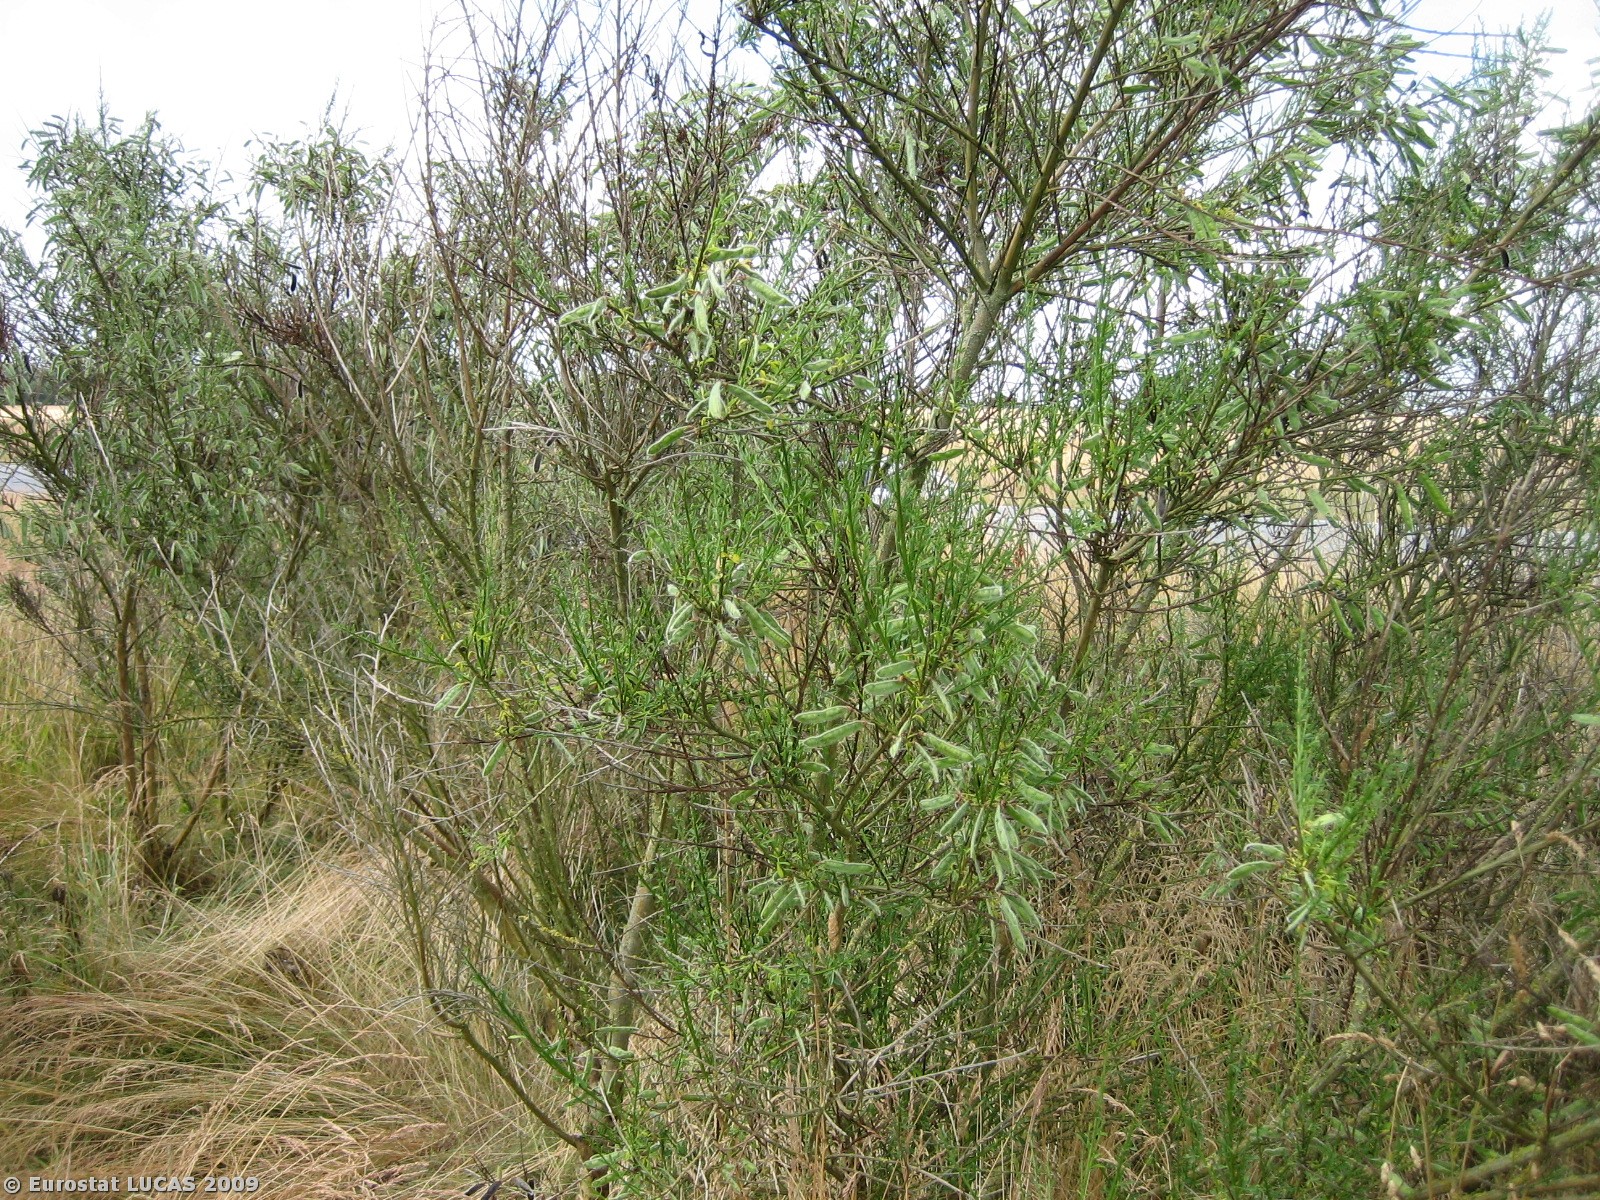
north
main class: Cropland
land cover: Rape and turnip rape
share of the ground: > 75 %
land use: Agriculture (excluding fallow land and kitchen gardens)
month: July
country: DK
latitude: 55.5138
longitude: 8.4969
